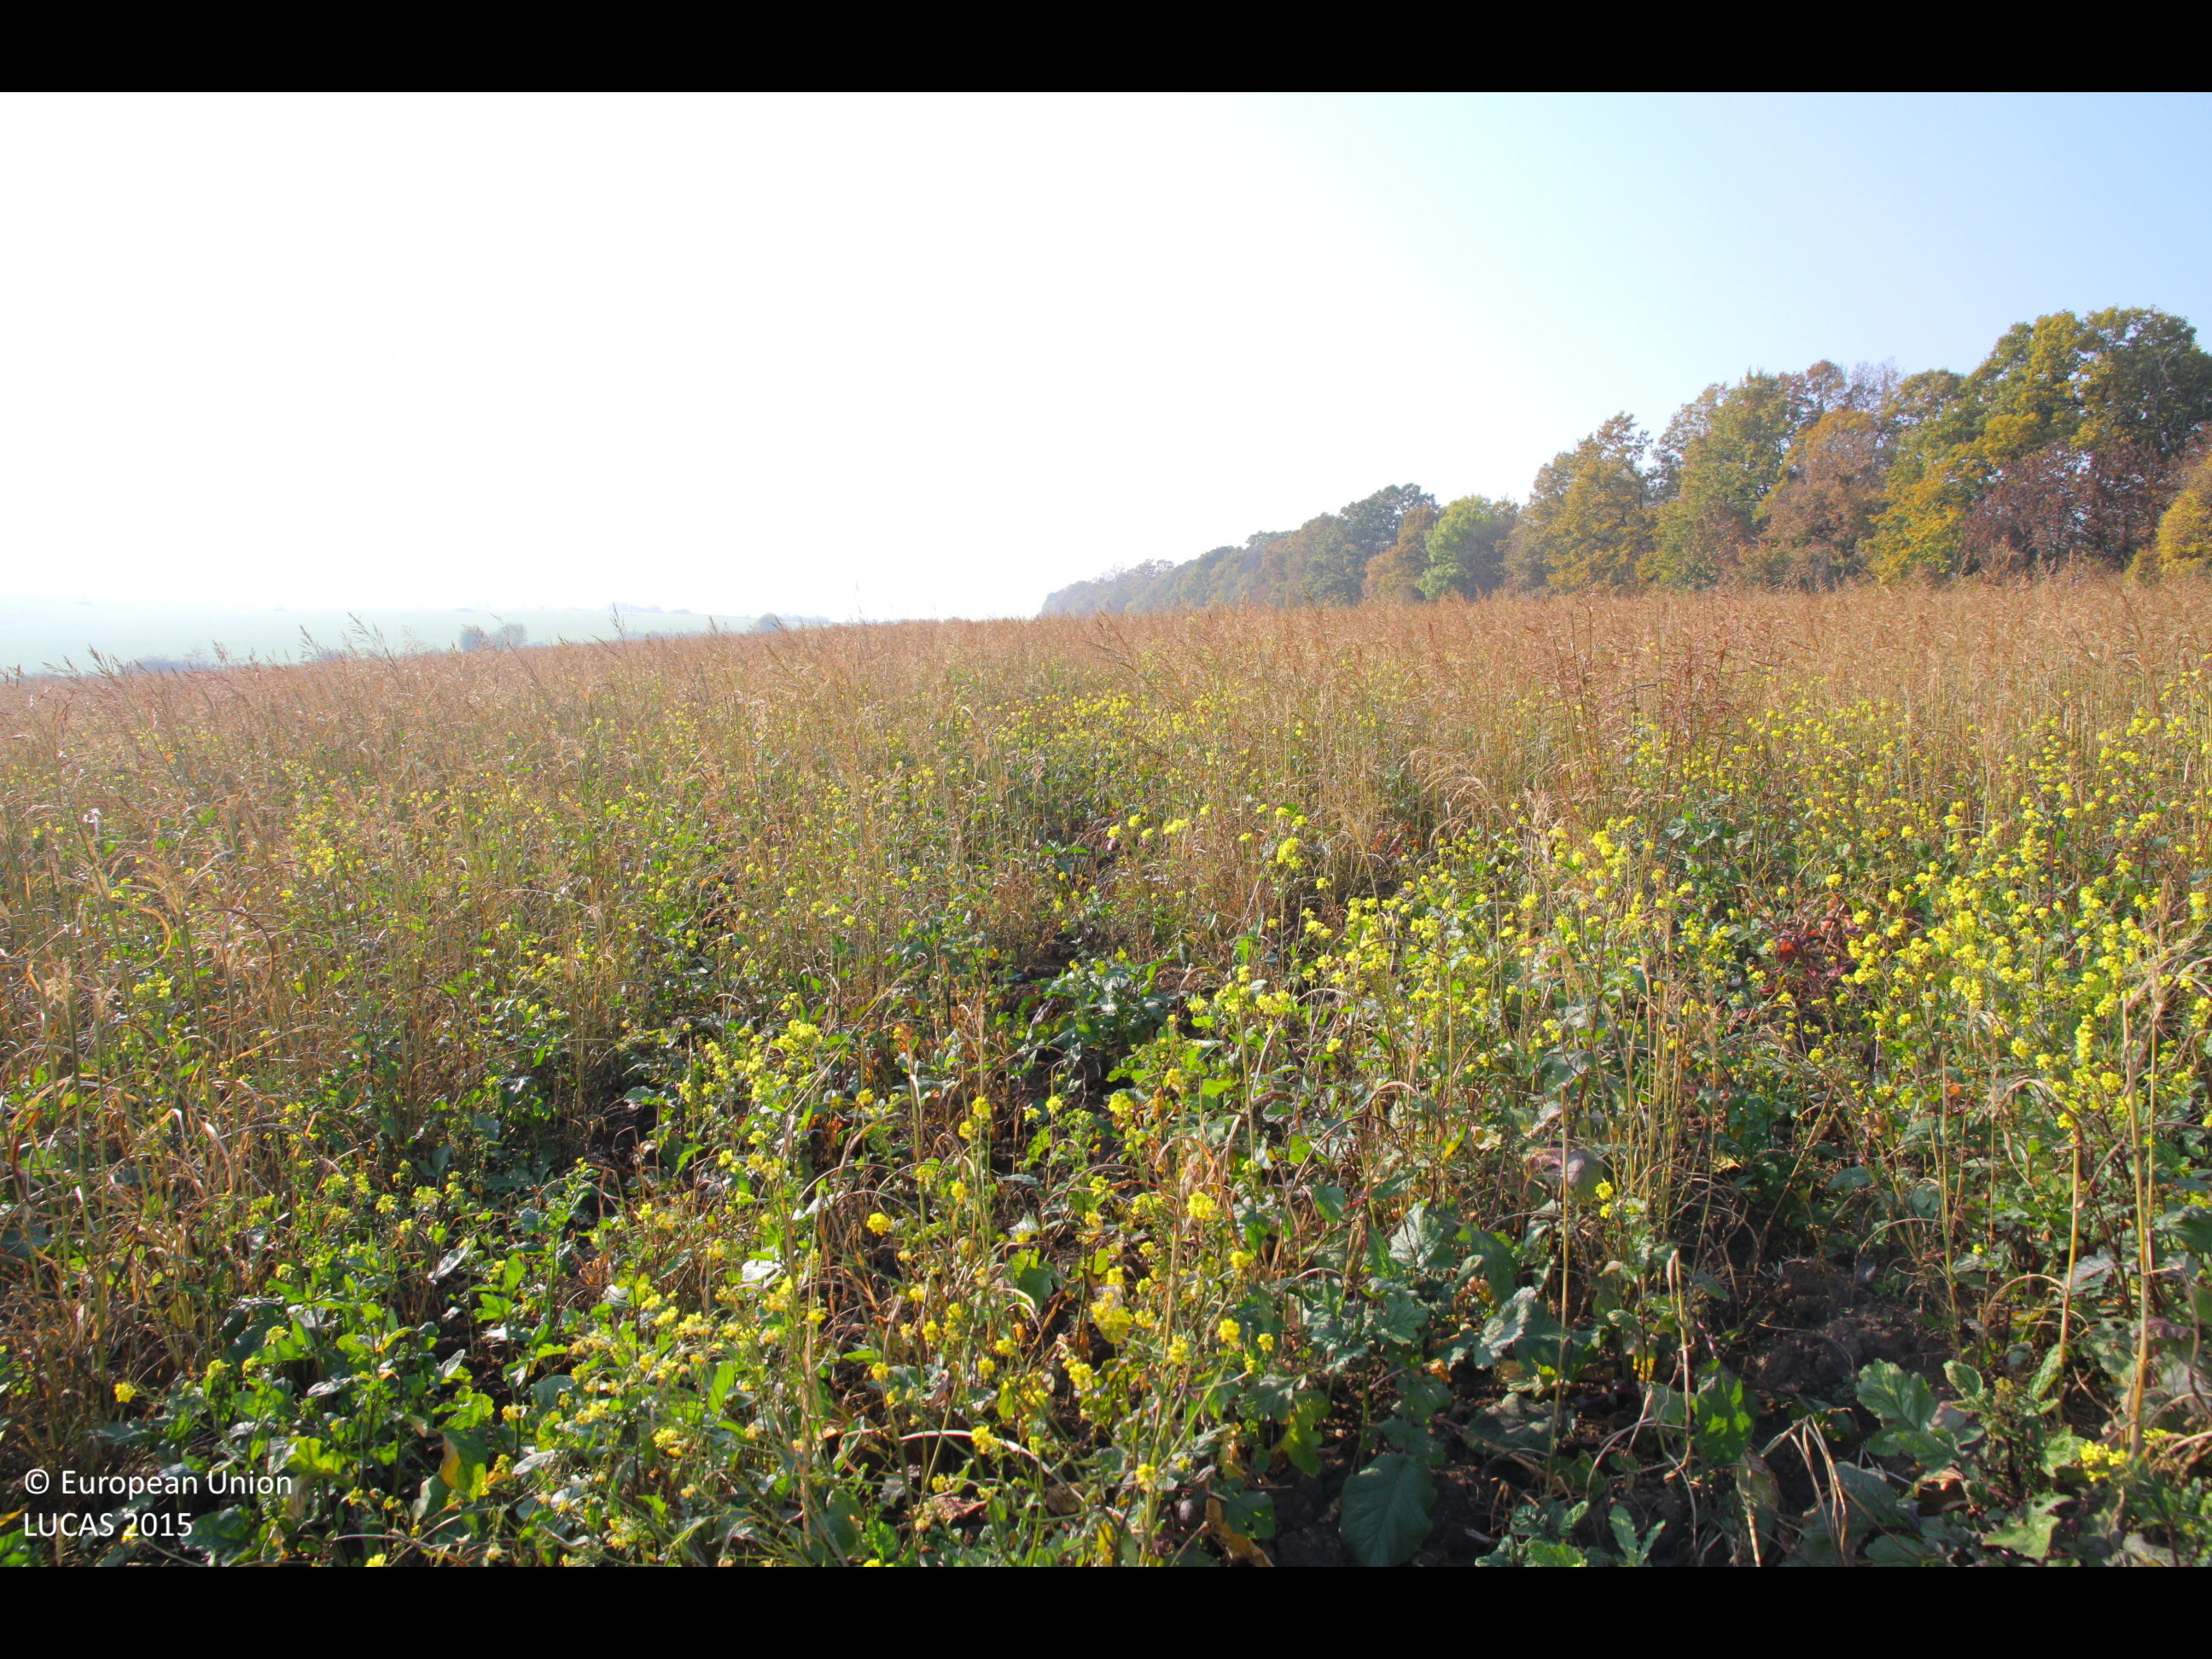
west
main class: Cropland
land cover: Rape and turnip rape
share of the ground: > 75 %
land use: Agriculture (excluding fallow land and kitchen gardens)
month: November
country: BG
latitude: 43.7050
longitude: 26.3473
